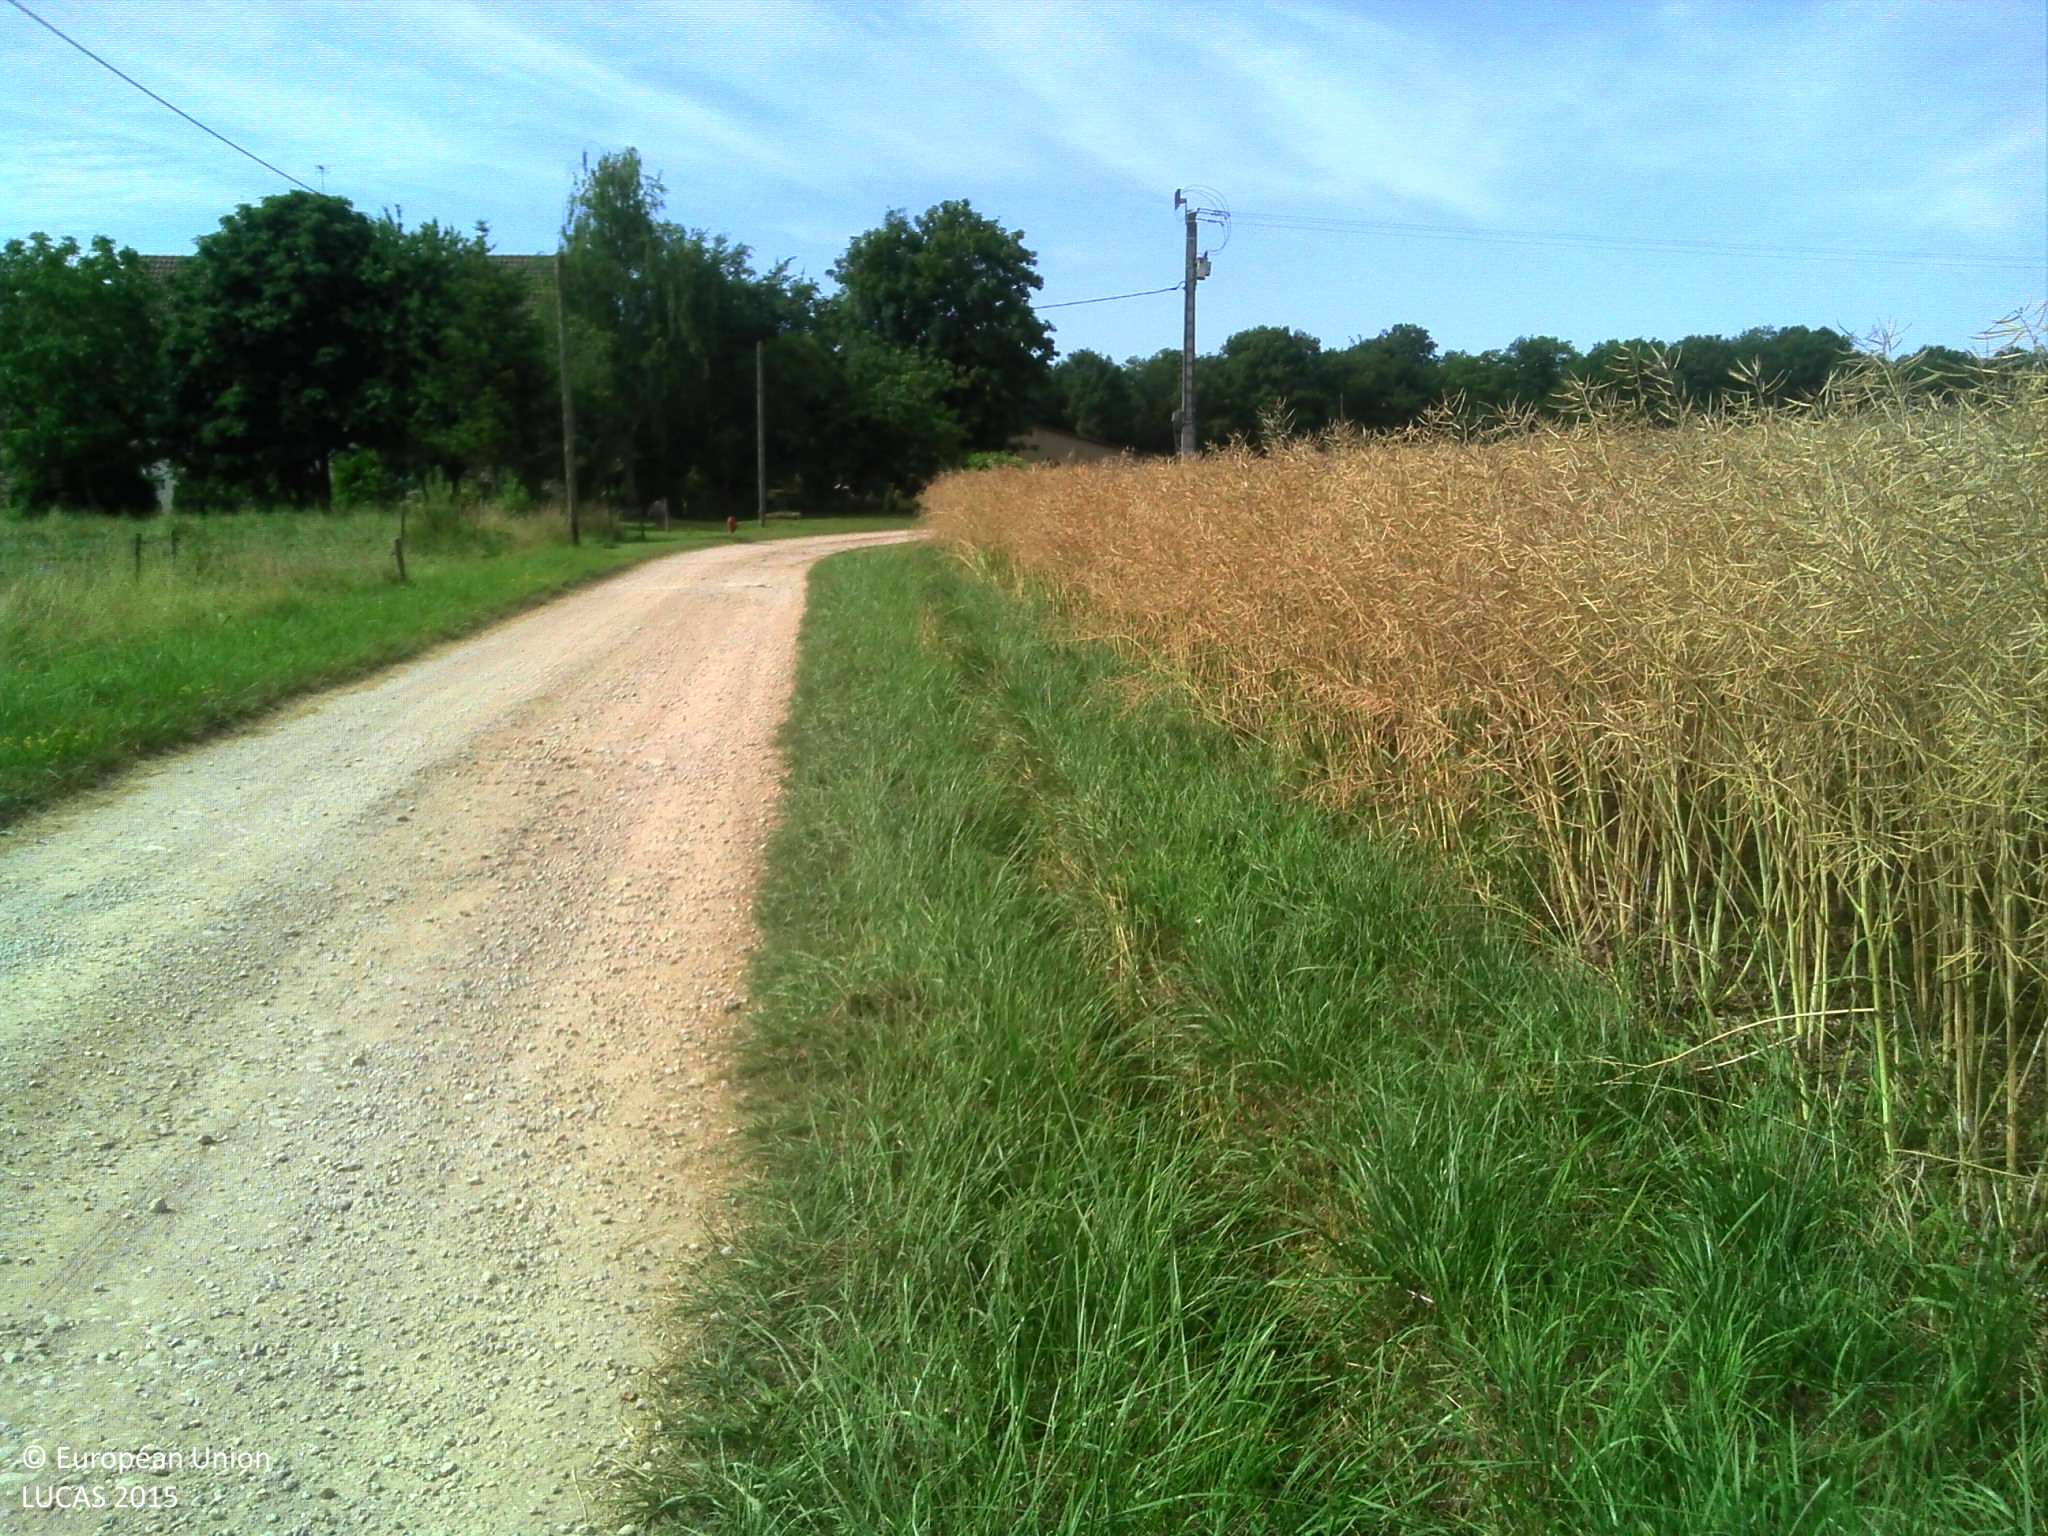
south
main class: Cropland
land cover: Rape and turnip rape
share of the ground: > 75 %
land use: Agriculture (excluding fallow land and kitchen gardens)
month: June
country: FR
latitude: 46.7111
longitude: 4.7820
